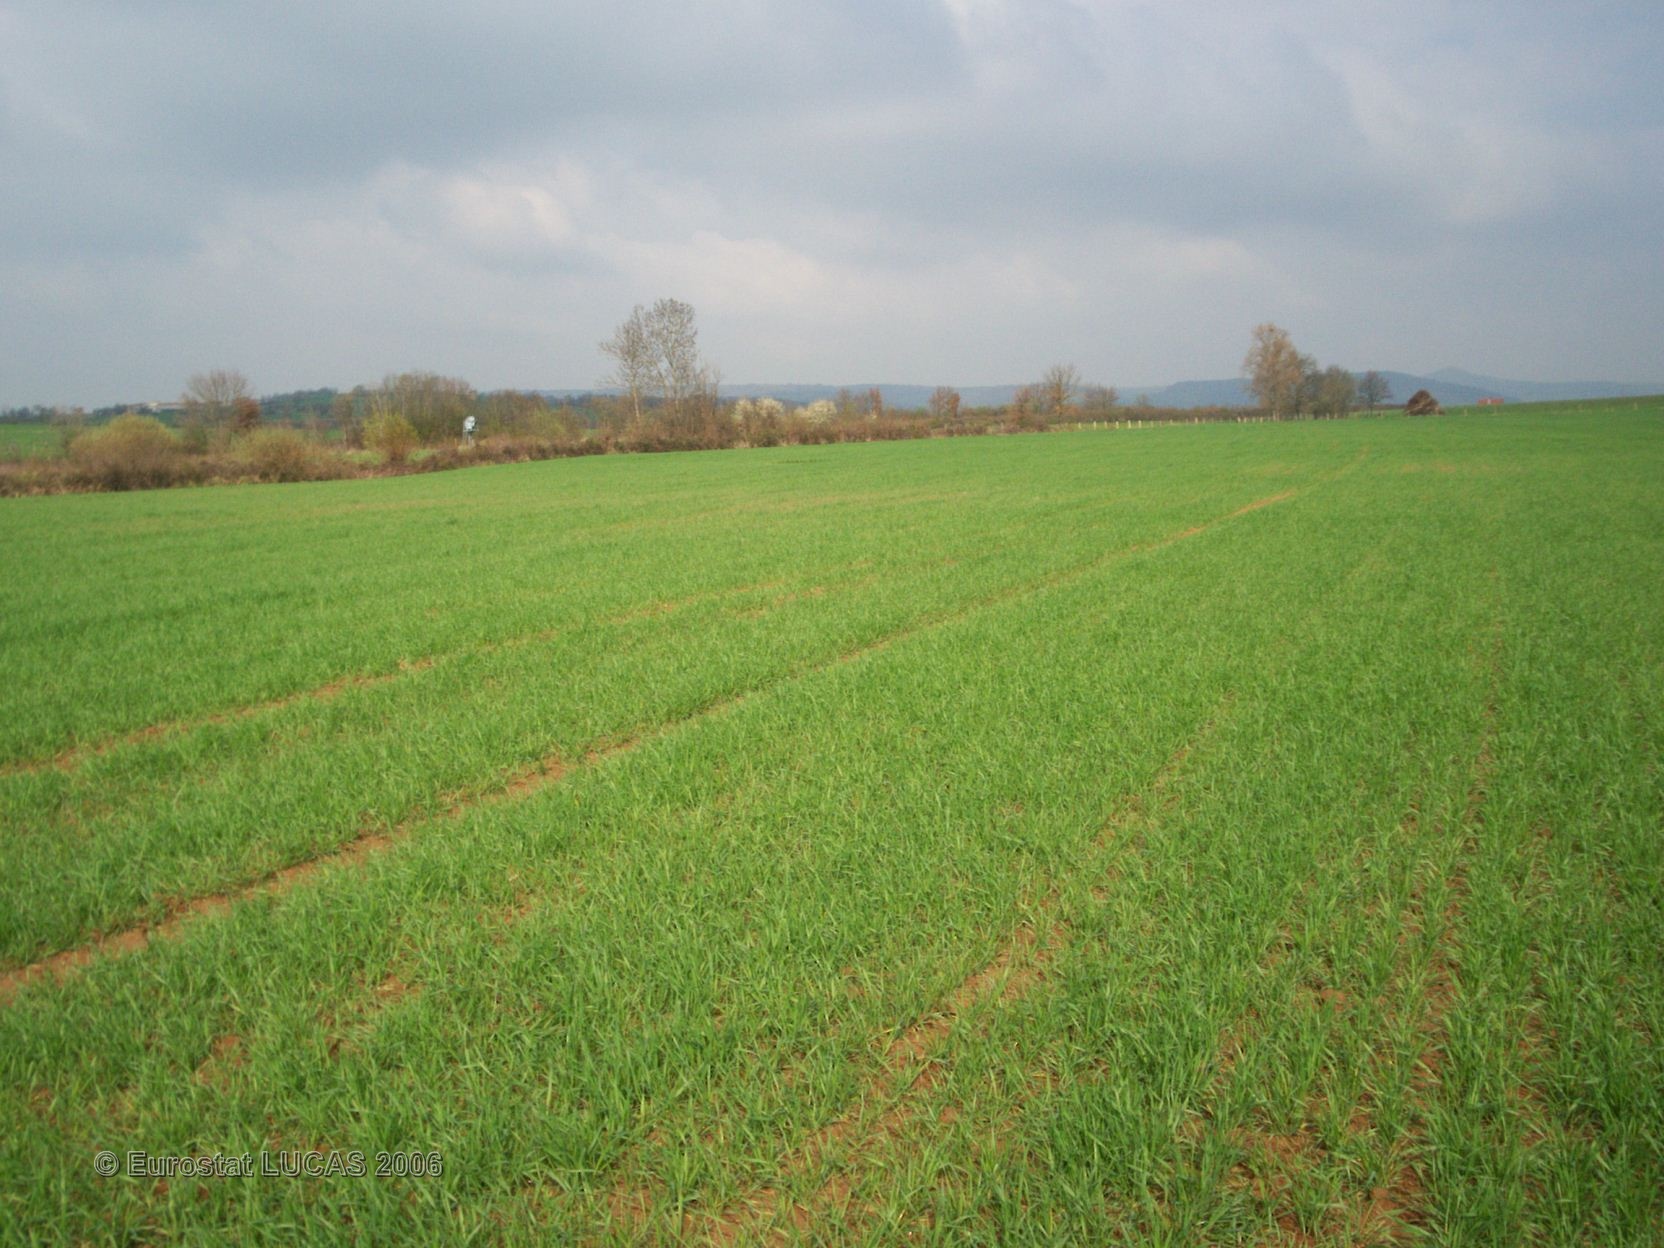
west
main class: Cropland
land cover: Common wheat
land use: Agriculture (excluding fallow land and kitchen gardens)
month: April
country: FR
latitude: 45.3638
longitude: 3.2991
